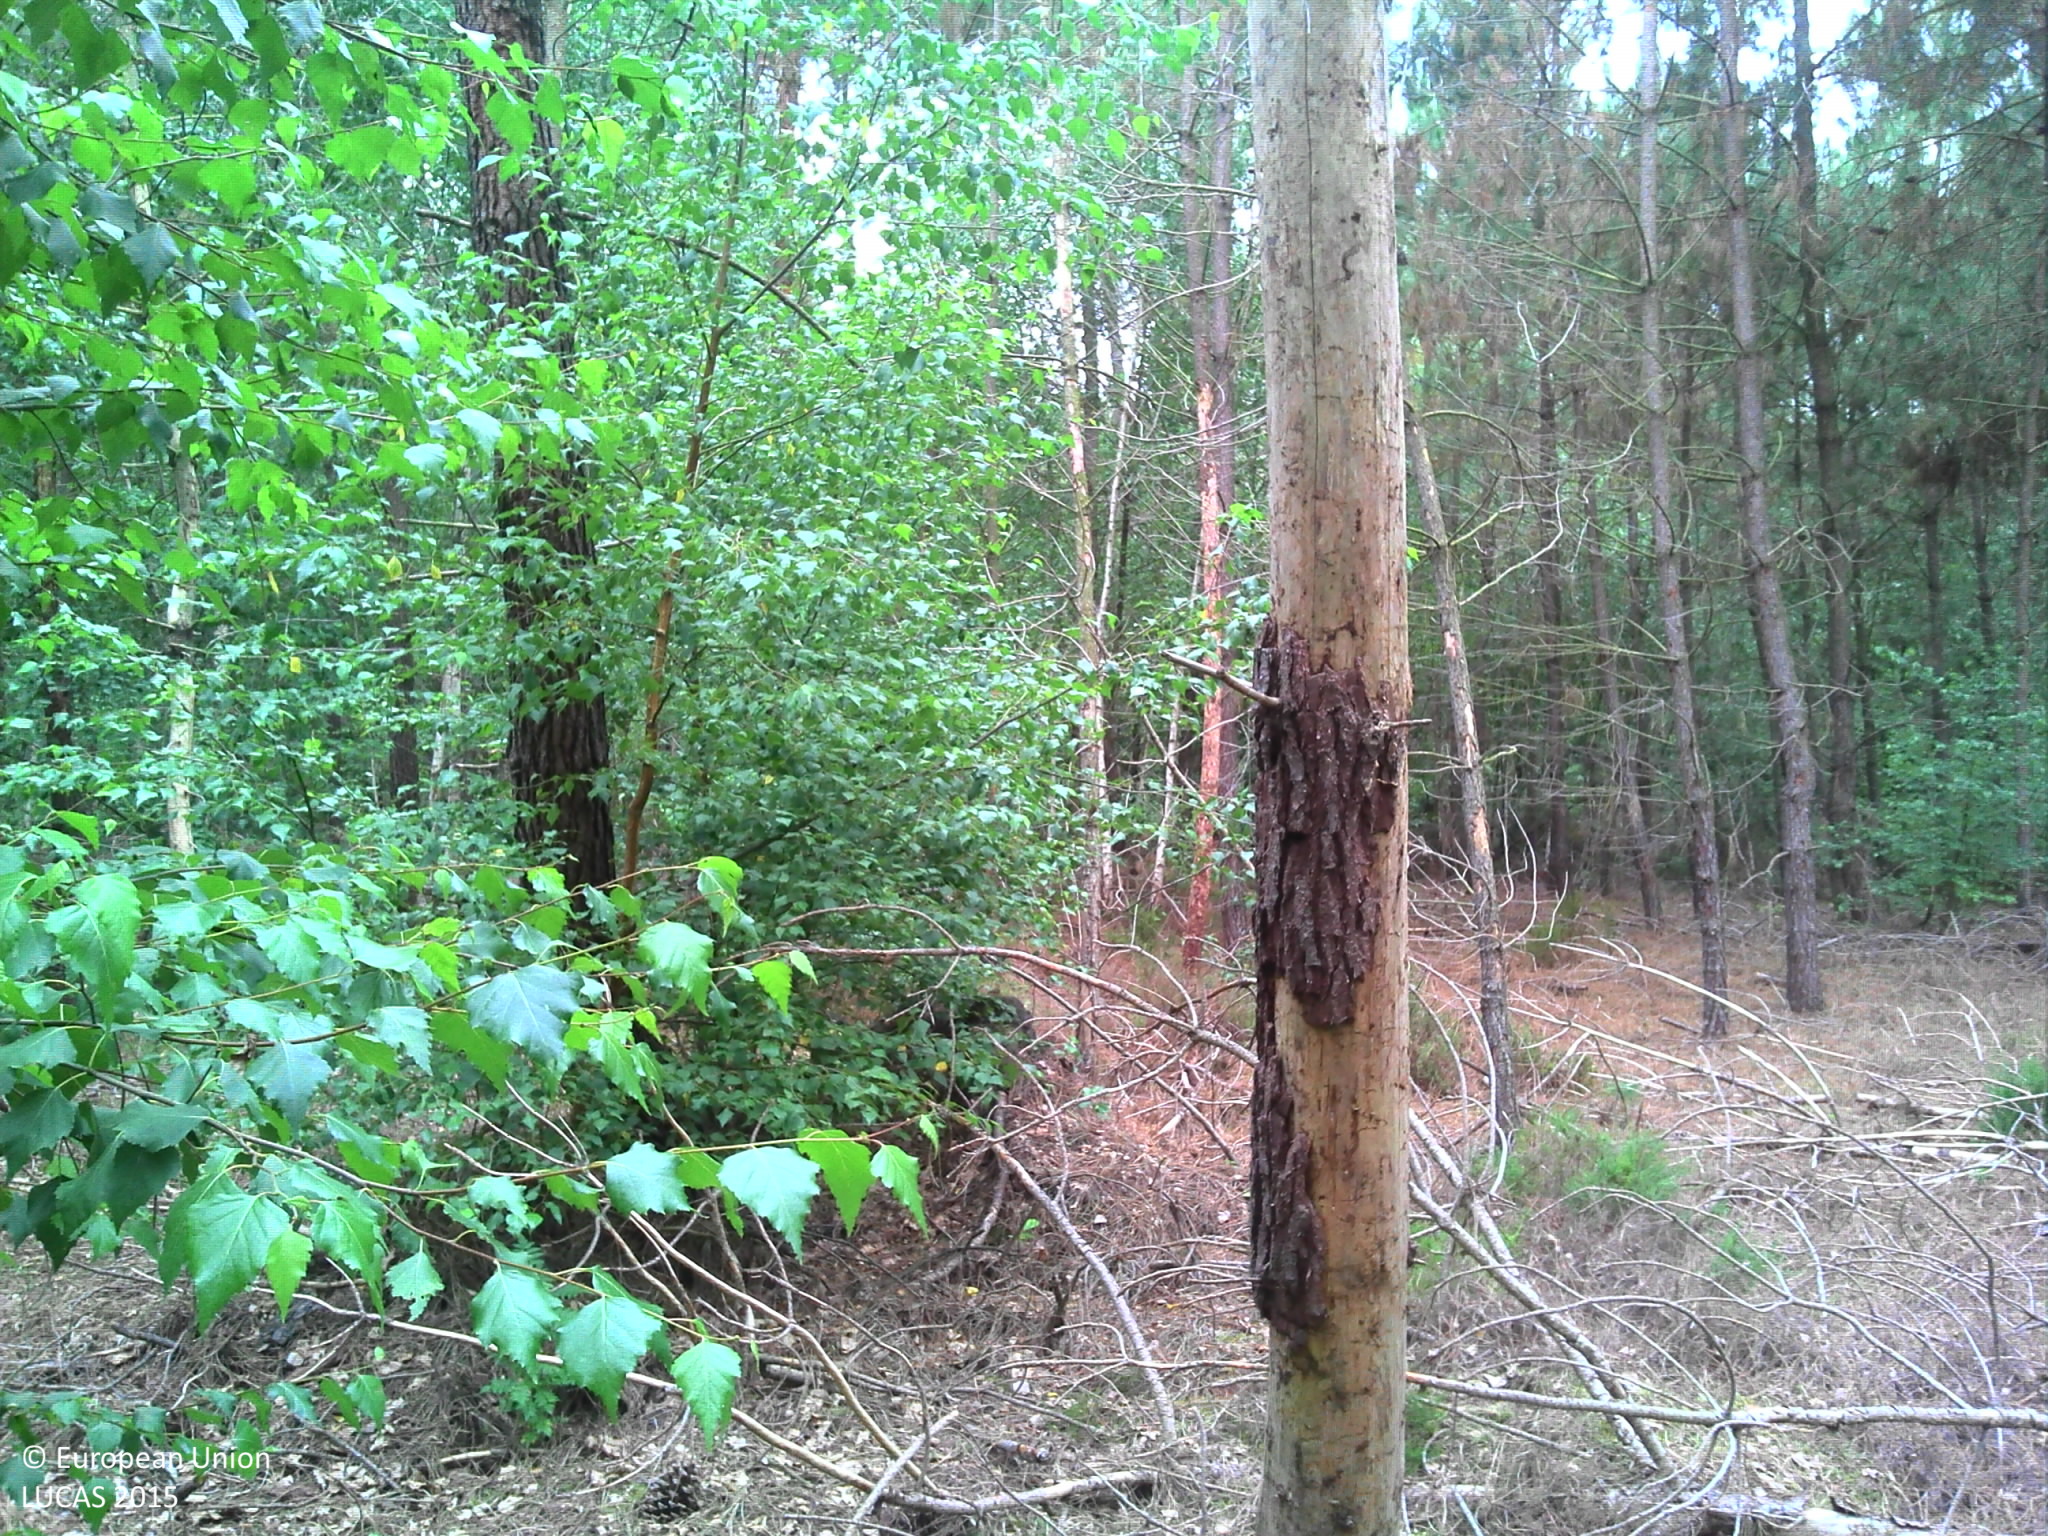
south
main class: Woodland
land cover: Pine dominated coniferous woodland
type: exotic forest
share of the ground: > 75 %
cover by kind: coniferous forest trees 60 %, herbaceous plants 30 %, shrubs 10 %
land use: Forestry
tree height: > 5 m
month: July
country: FR
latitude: 47.8884
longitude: 0.3331
